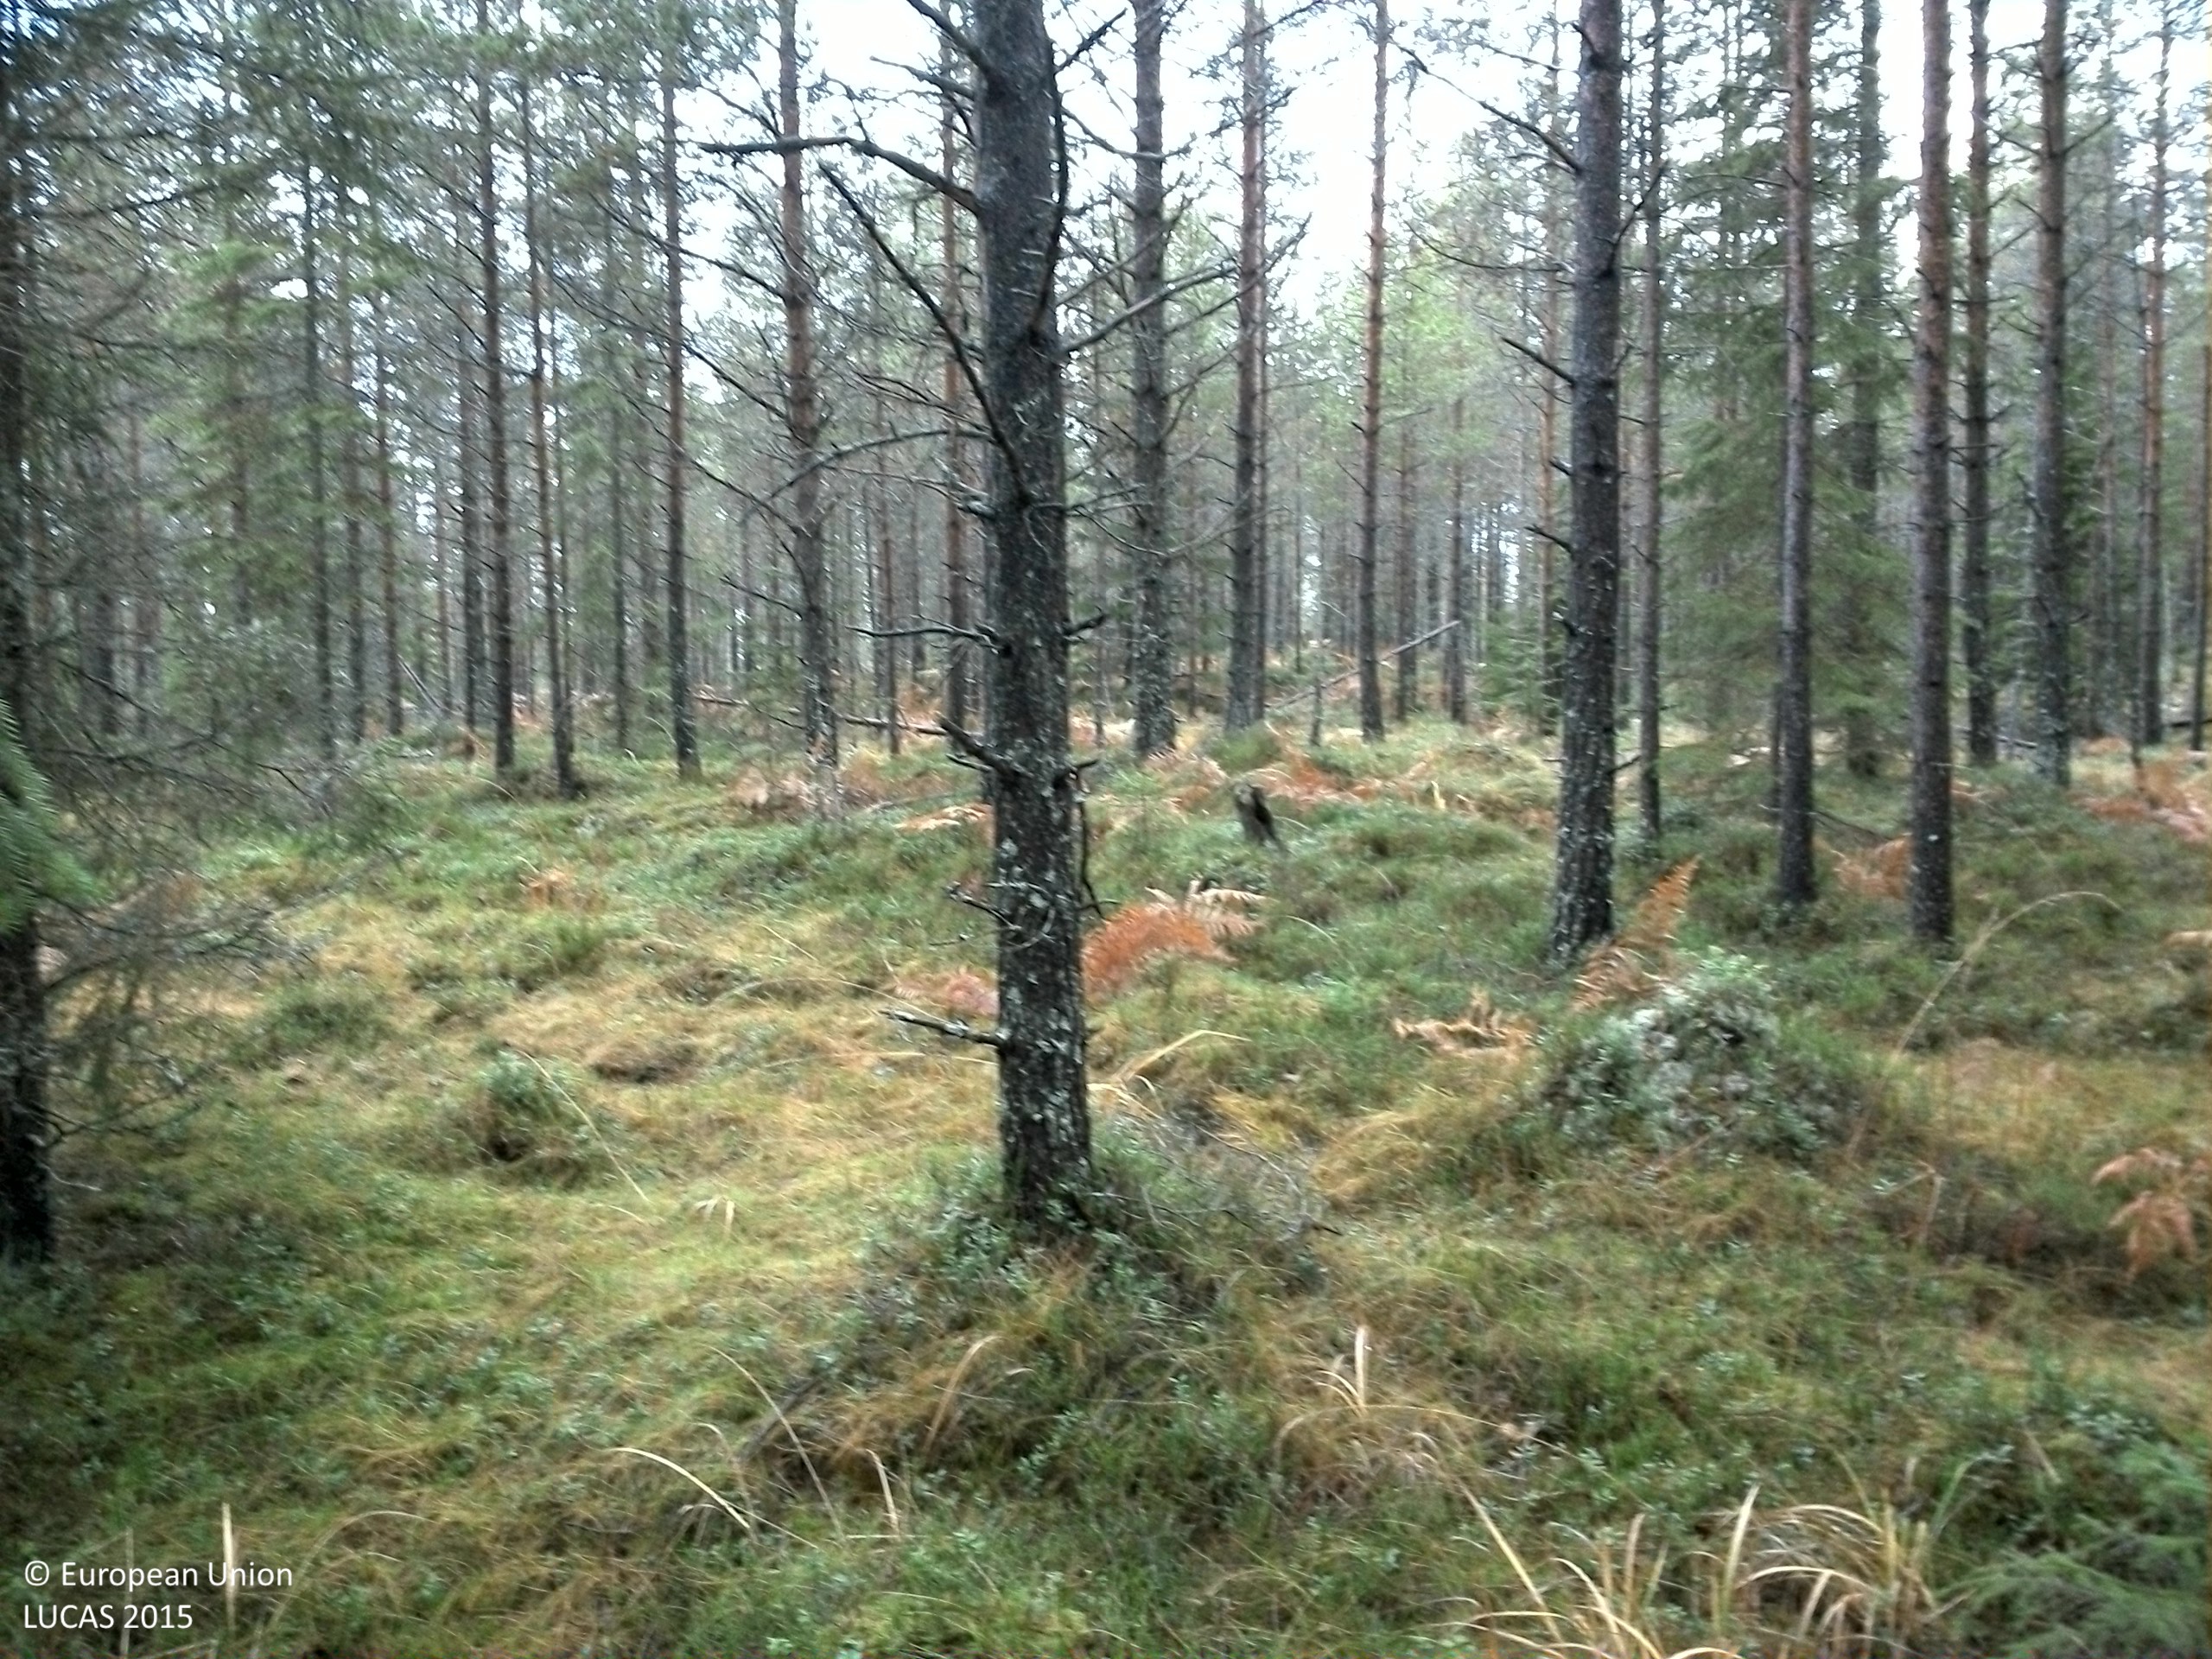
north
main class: Woodland
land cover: Pine dominated coniferous woodland
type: boreal forest
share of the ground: > 75 %
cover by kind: coniferous forest trees 75 %, shrubs 15 %, herbaceous plants 5 %, lichens and mosses 5 %
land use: Forestry
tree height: > 5 m
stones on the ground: 10 - 25 %
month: November
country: SE
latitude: 59.9545
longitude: 15.3075
